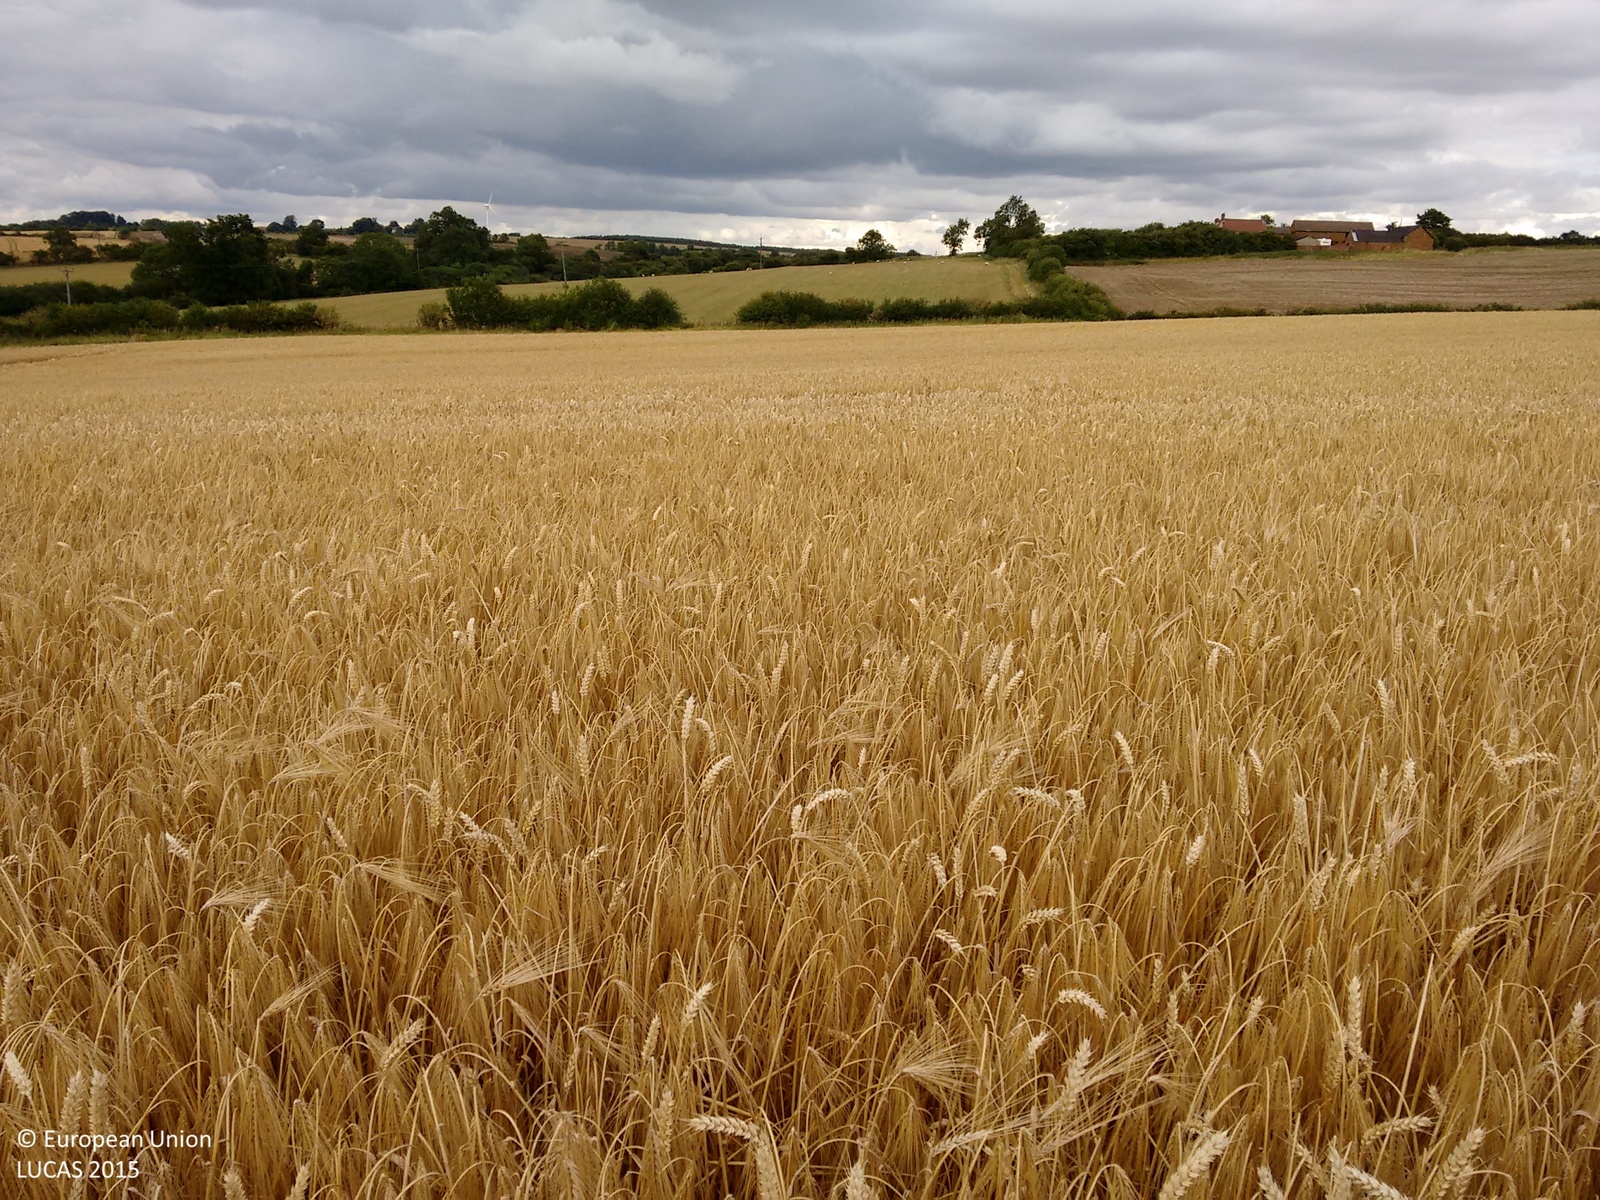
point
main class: Cropland
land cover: Mixed cereals for fodder
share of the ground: > 75 %
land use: Agriculture (excluding fallow land and kitchen gardens)
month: July
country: GB
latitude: 52.7964
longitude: -0.7337
